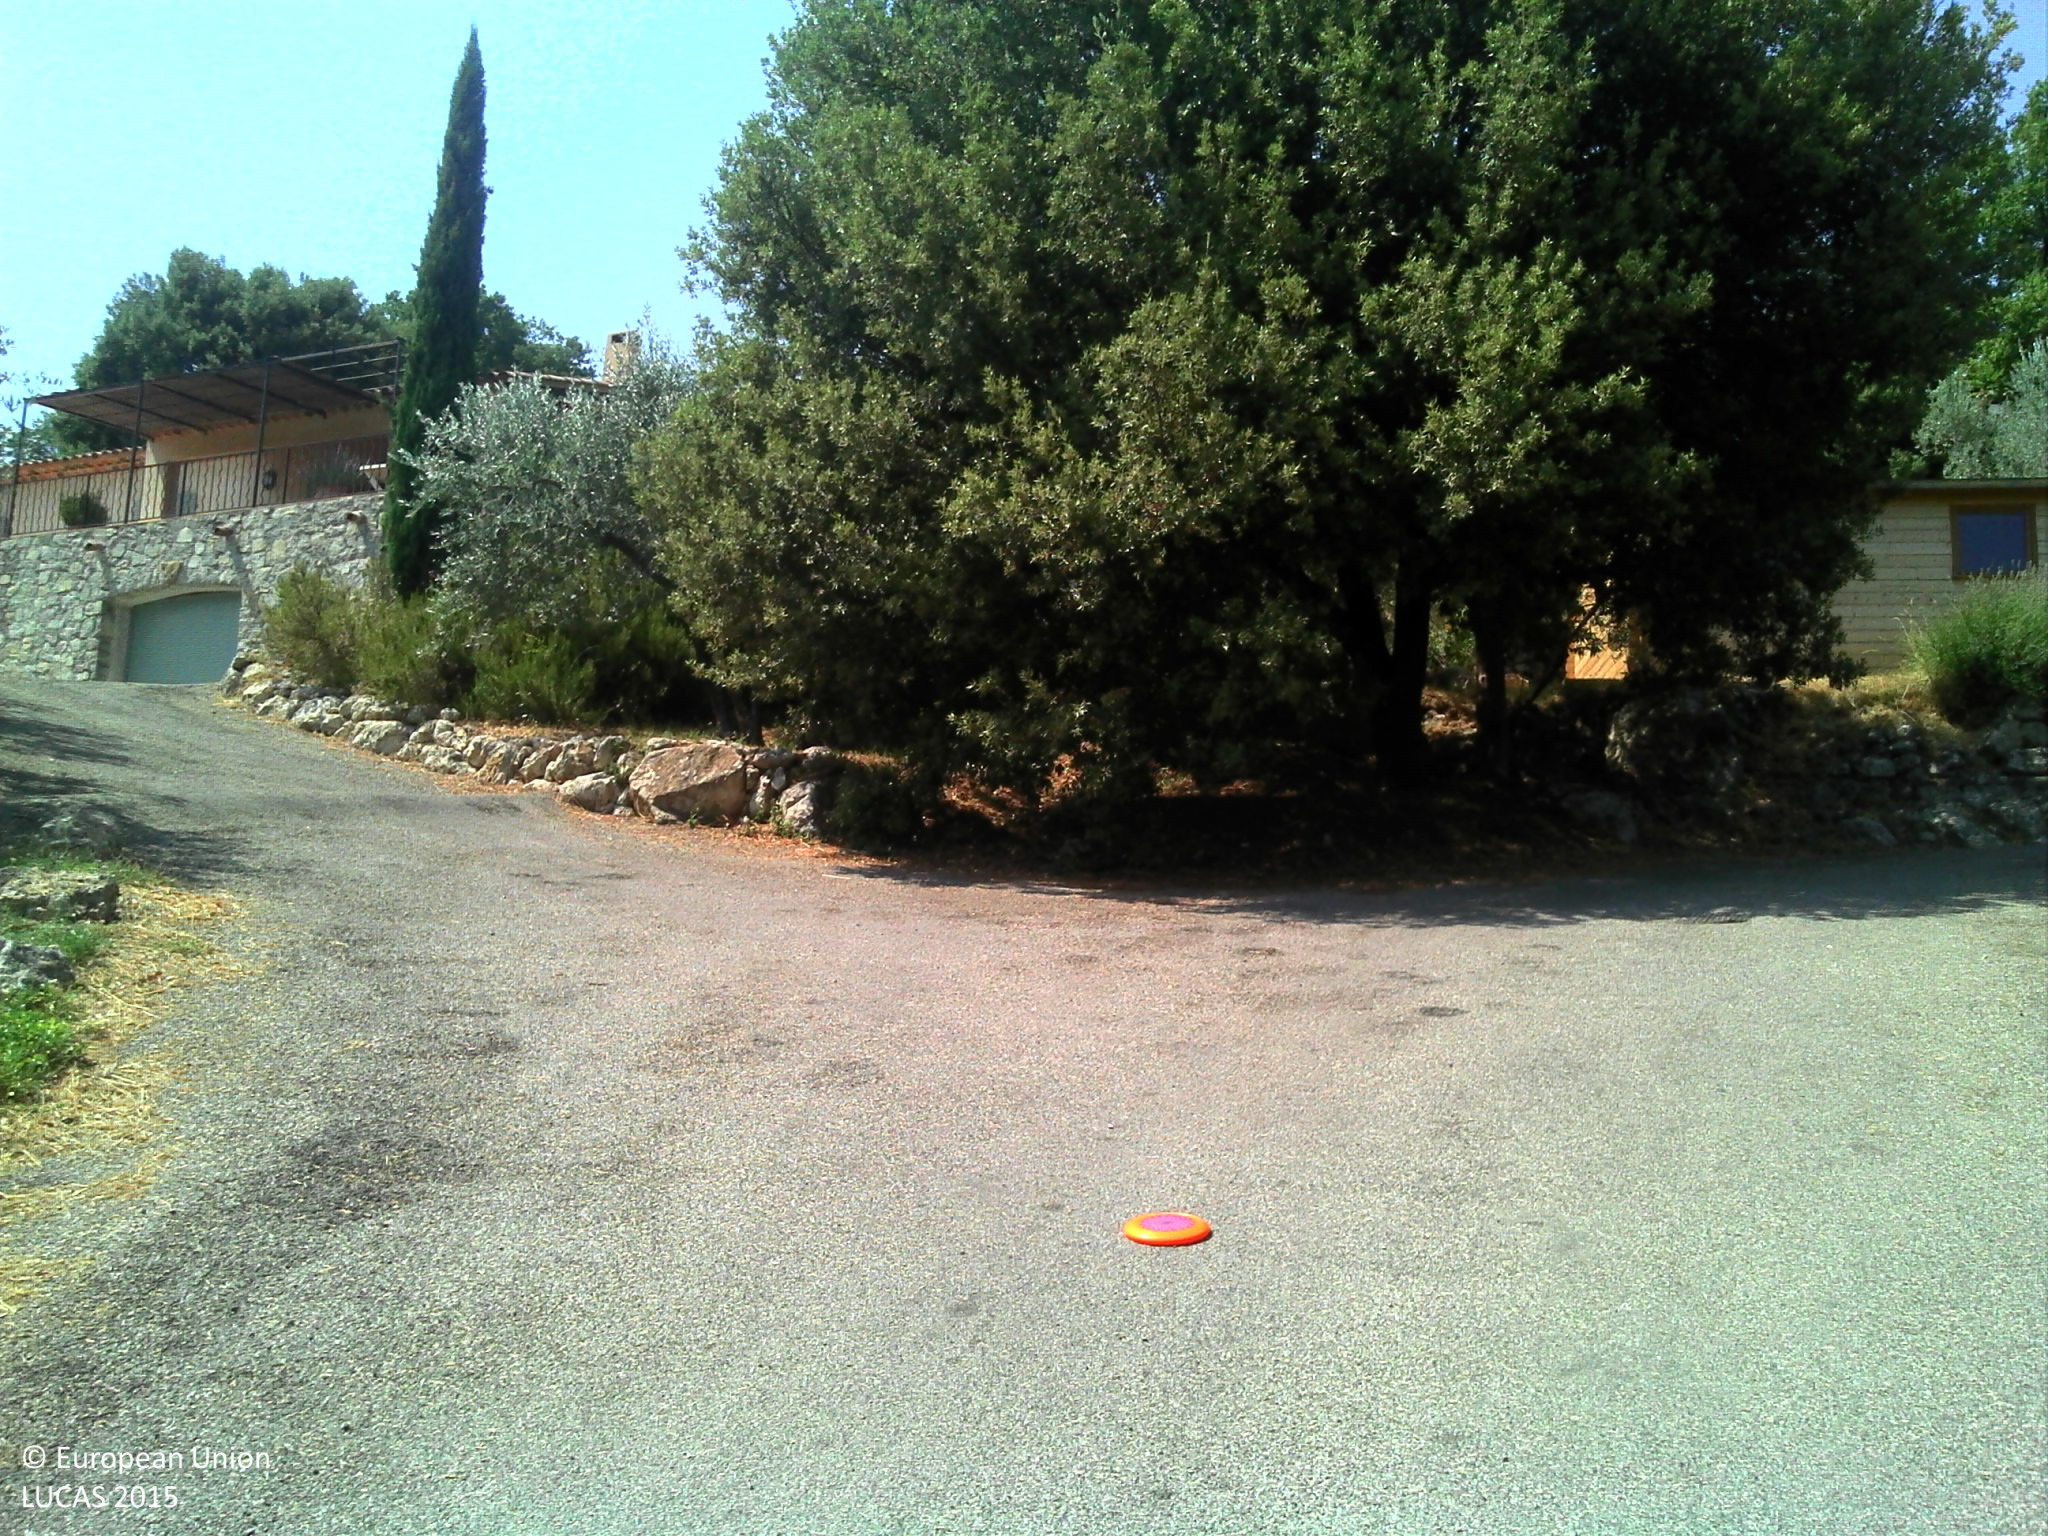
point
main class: Grassland
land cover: Grassland with sparse tree/shrub cover
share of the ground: > 75 %
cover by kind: herbaceous plants 85 %, shrubs 10 %, coniferous forest trees 5 %
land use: Residential
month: August
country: FR
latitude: 43.5694
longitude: 6.5043
